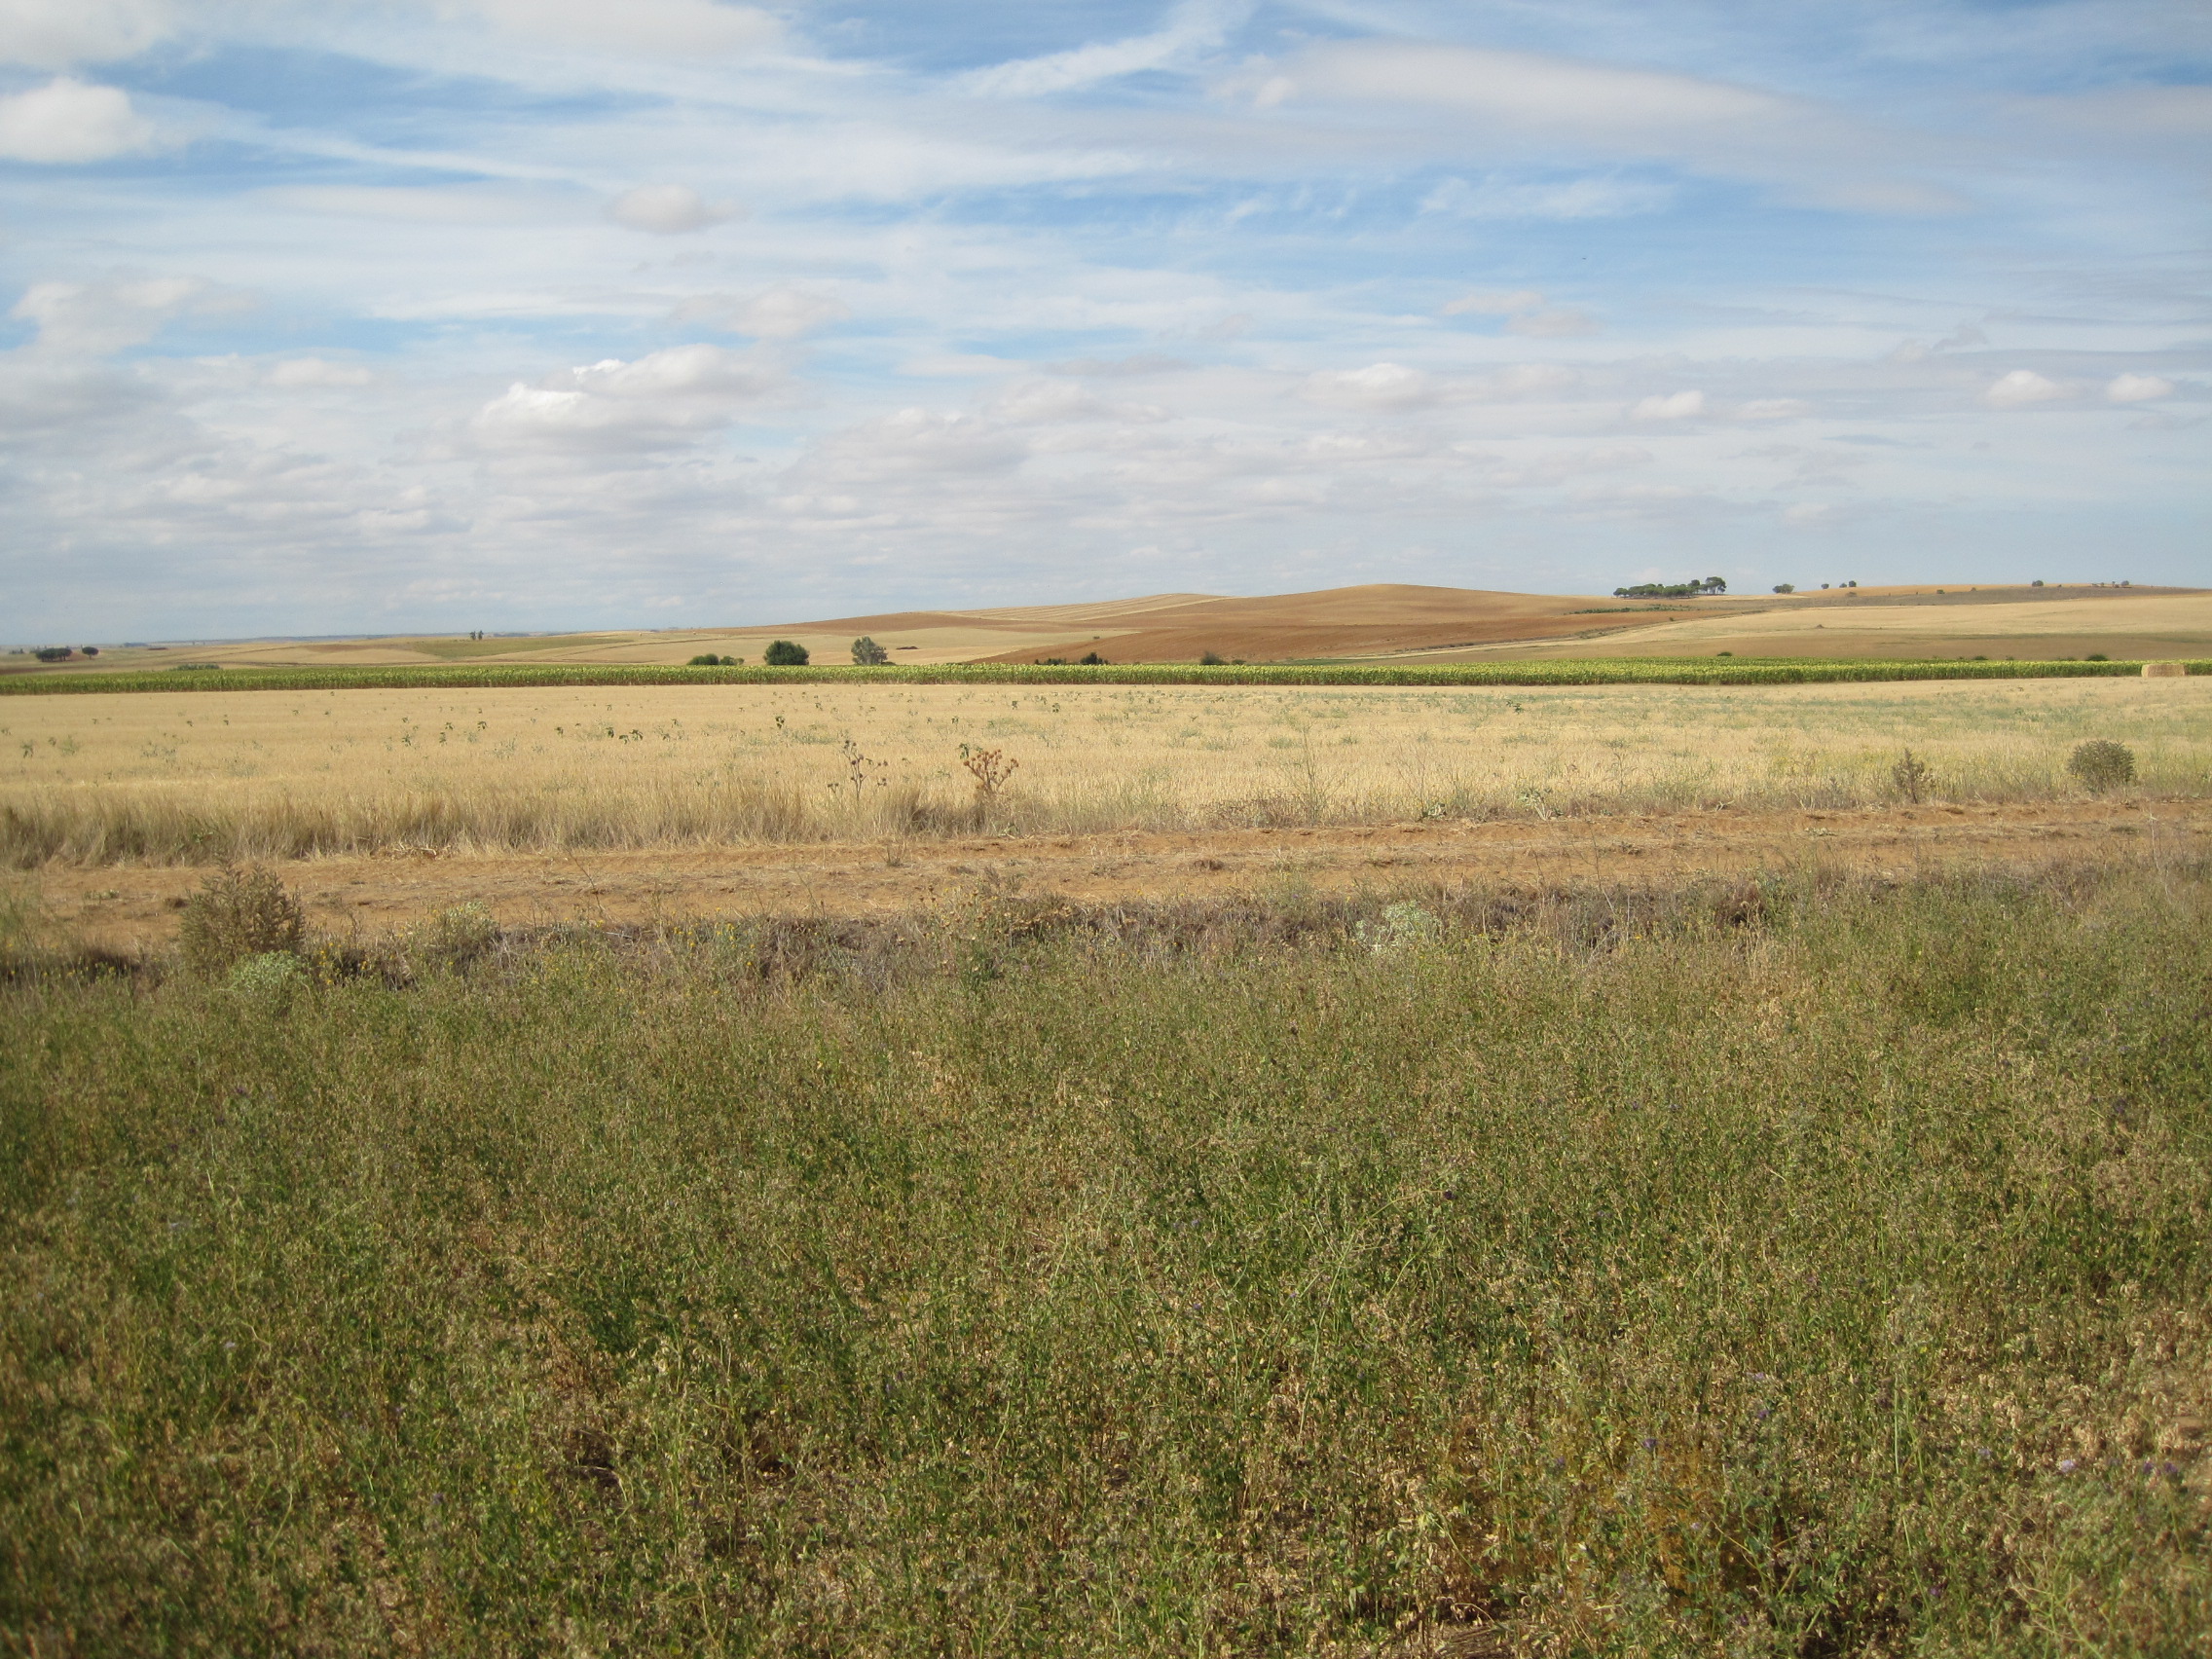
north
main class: Cropland
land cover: Lucerne
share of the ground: > 75 %
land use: Agriculture (excluding fallow land and kitchen gardens)
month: July
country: ES
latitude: 41.9860
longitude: -5.2553
